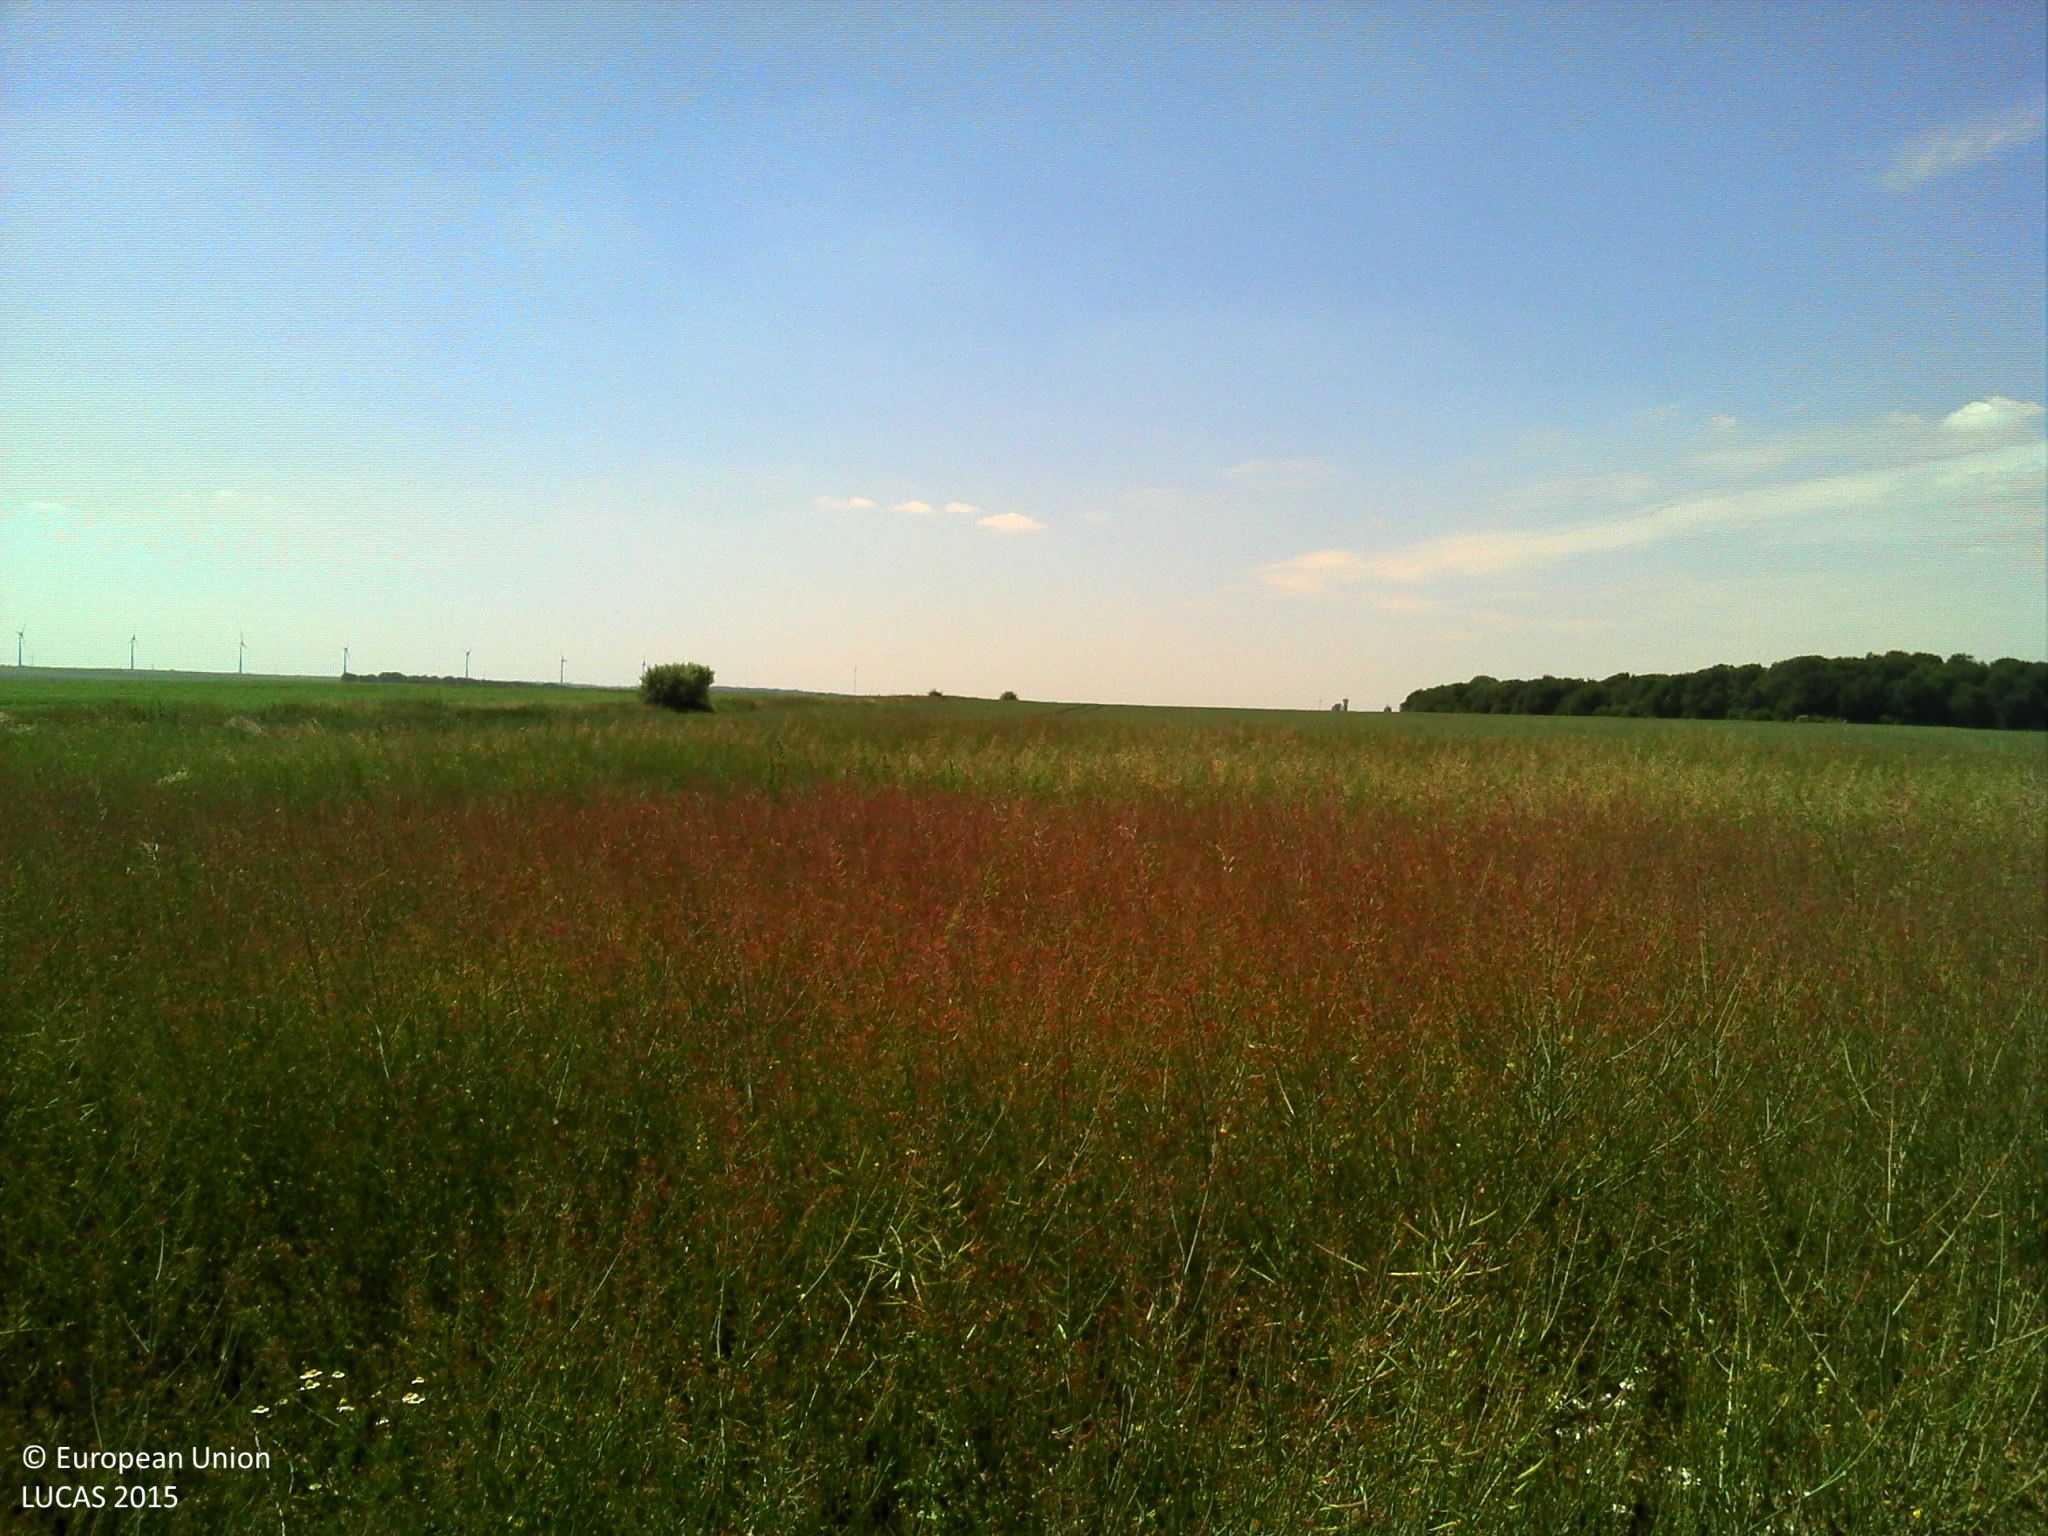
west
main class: Cropland
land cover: Rape and turnip rape
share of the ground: > 75 %
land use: Agriculture (excluding fallow land and kitchen gardens)
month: June
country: FR
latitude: 49.5065
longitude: 2.5447
